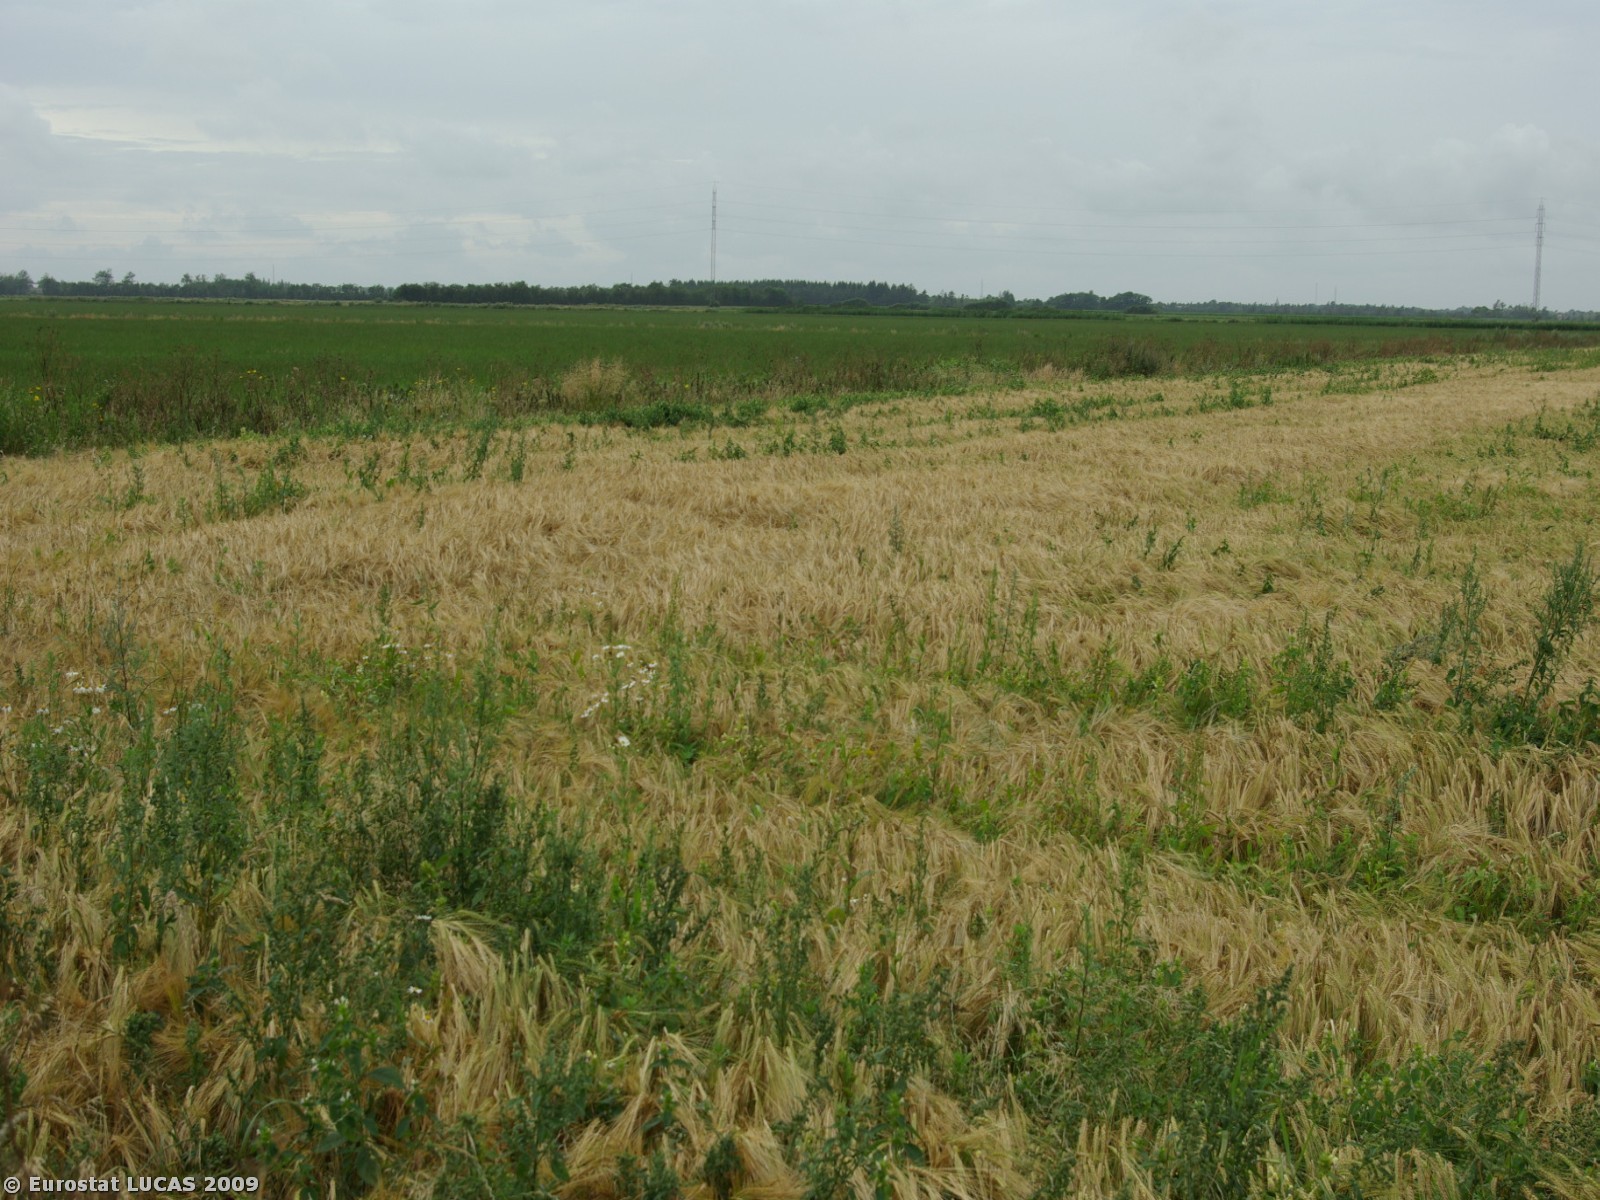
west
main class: Cropland
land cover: Barley
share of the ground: > 75 %
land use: Agriculture (excluding fallow land and kitchen gardens)
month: July
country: DK
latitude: 55.1041
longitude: 8.8567
